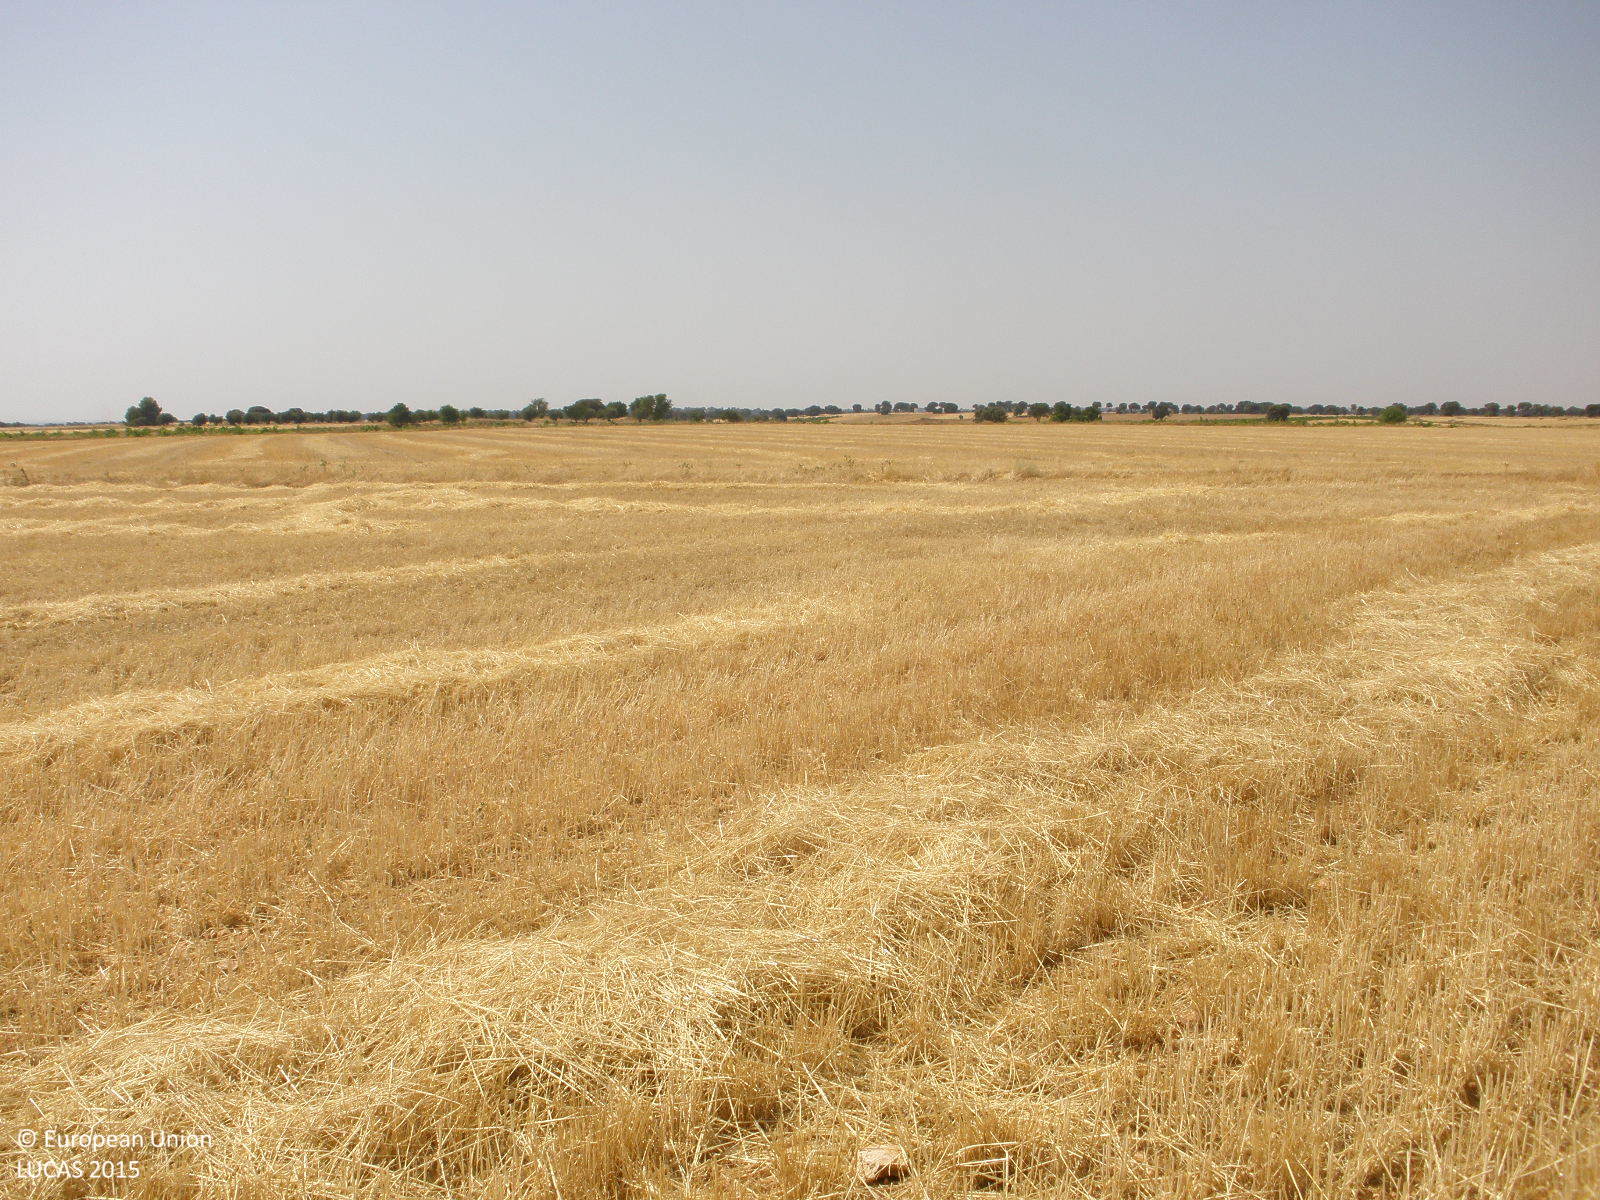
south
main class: Cropland
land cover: Common wheat
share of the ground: < 10 %
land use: Agriculture (excluding fallow land and kitchen gardens)
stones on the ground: 10 - 25 %
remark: Harvested field
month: July
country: ES
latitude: 39.9252
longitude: -3.1642
